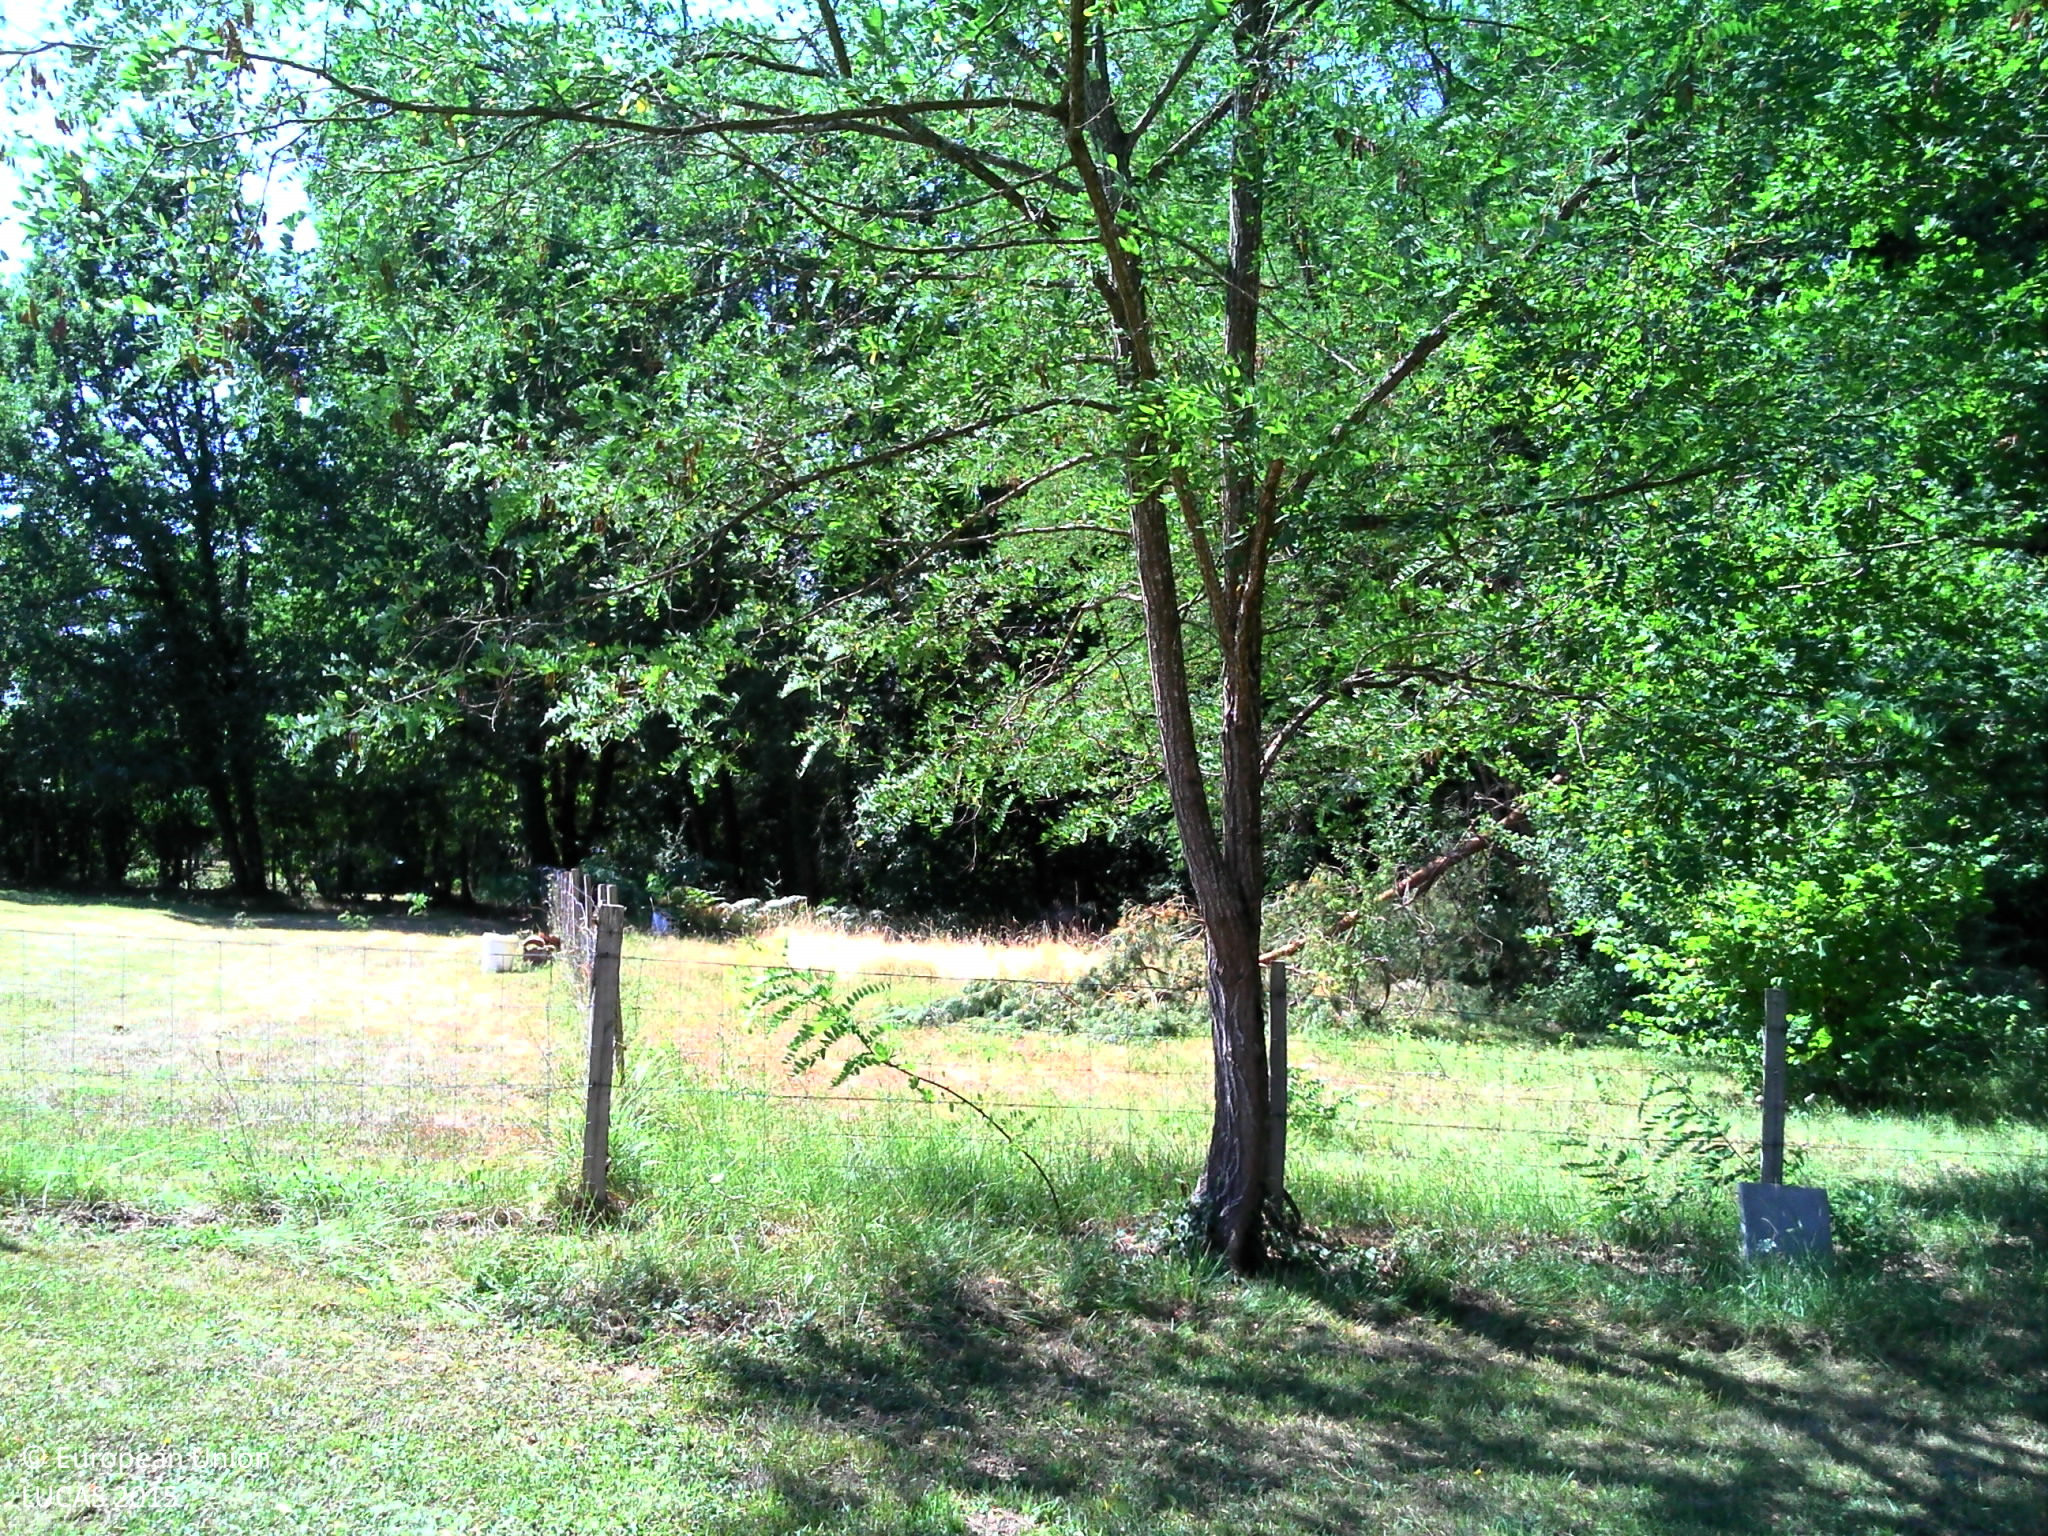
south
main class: Grassland
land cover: Grassland with sparse tree/shrub cover
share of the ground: > 75 %
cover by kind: herbaceous plants 95 %, broadleaved forest trees 5 %
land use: Residential
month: July
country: FR
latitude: 44.9011
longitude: 0.5812
